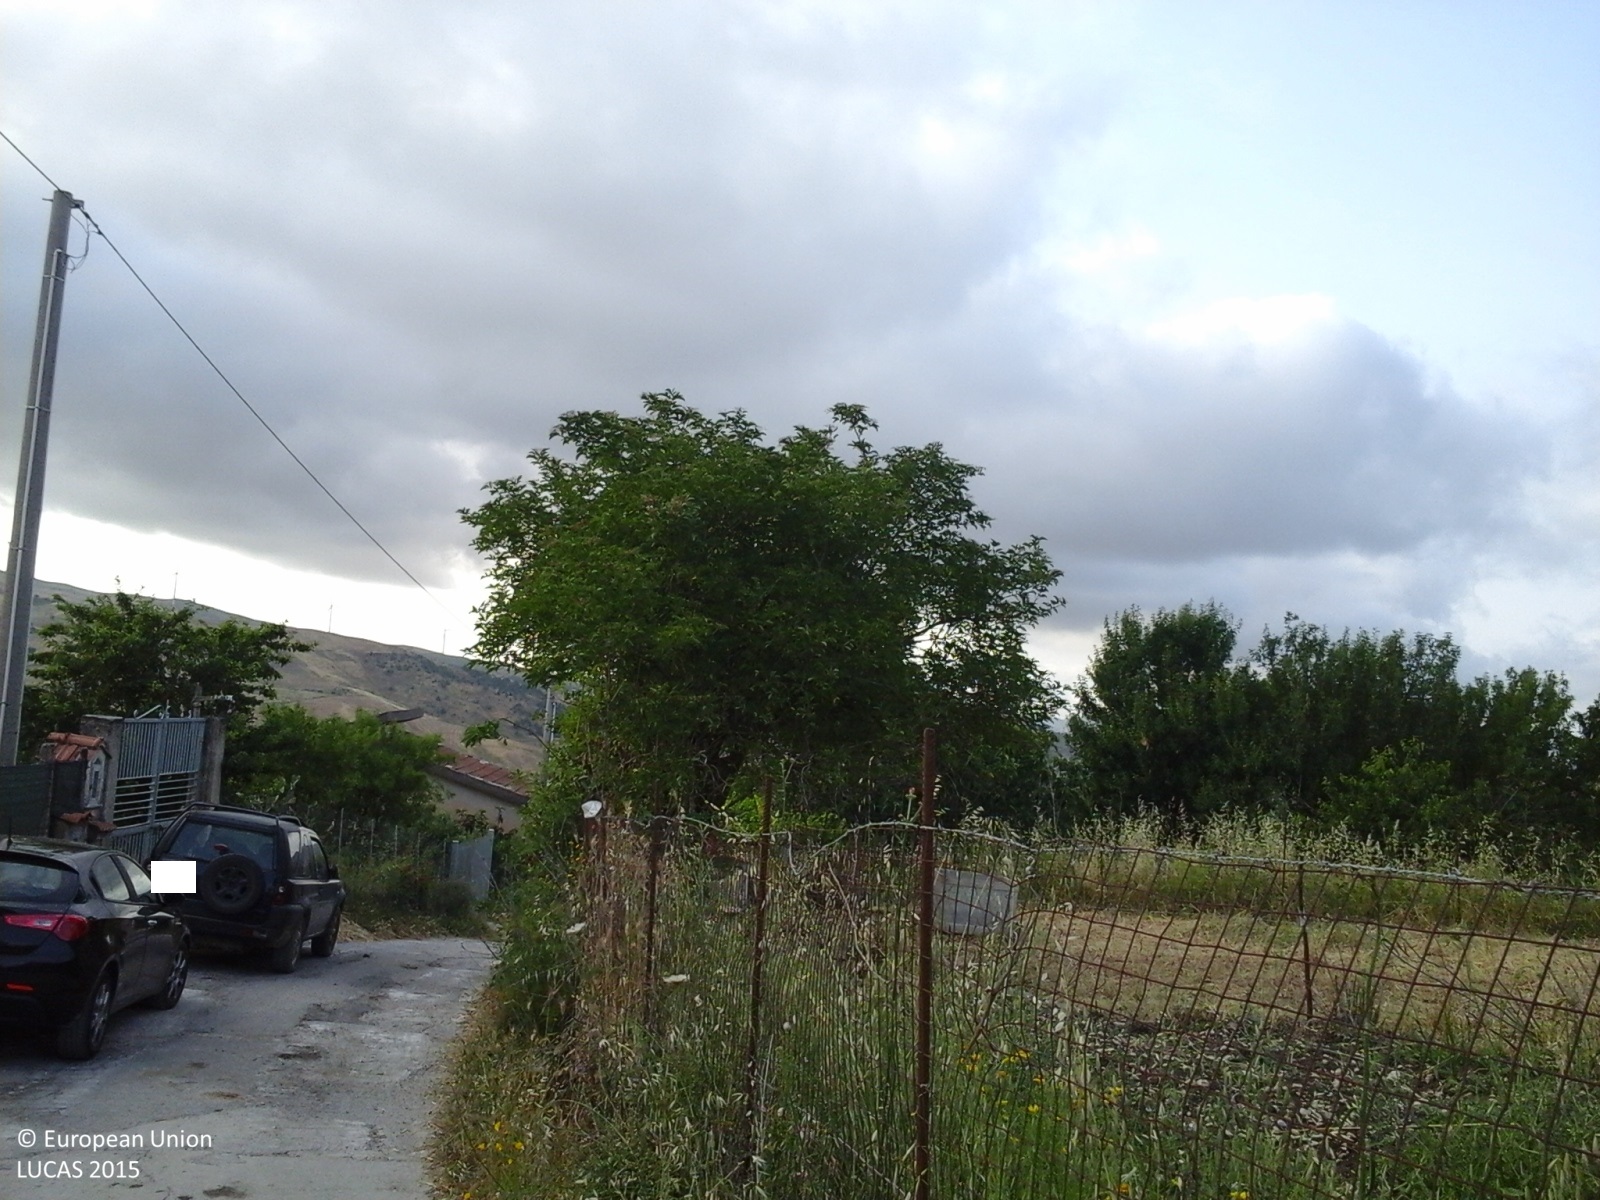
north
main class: Grassland
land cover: Grassland without tree/shrub cover
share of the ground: > 75 %
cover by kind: herbaceous plants 100 %
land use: Agriculture (excluding fallow land and kitchen gardens)
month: June
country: IT
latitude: 37.7514
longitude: 13.6168
